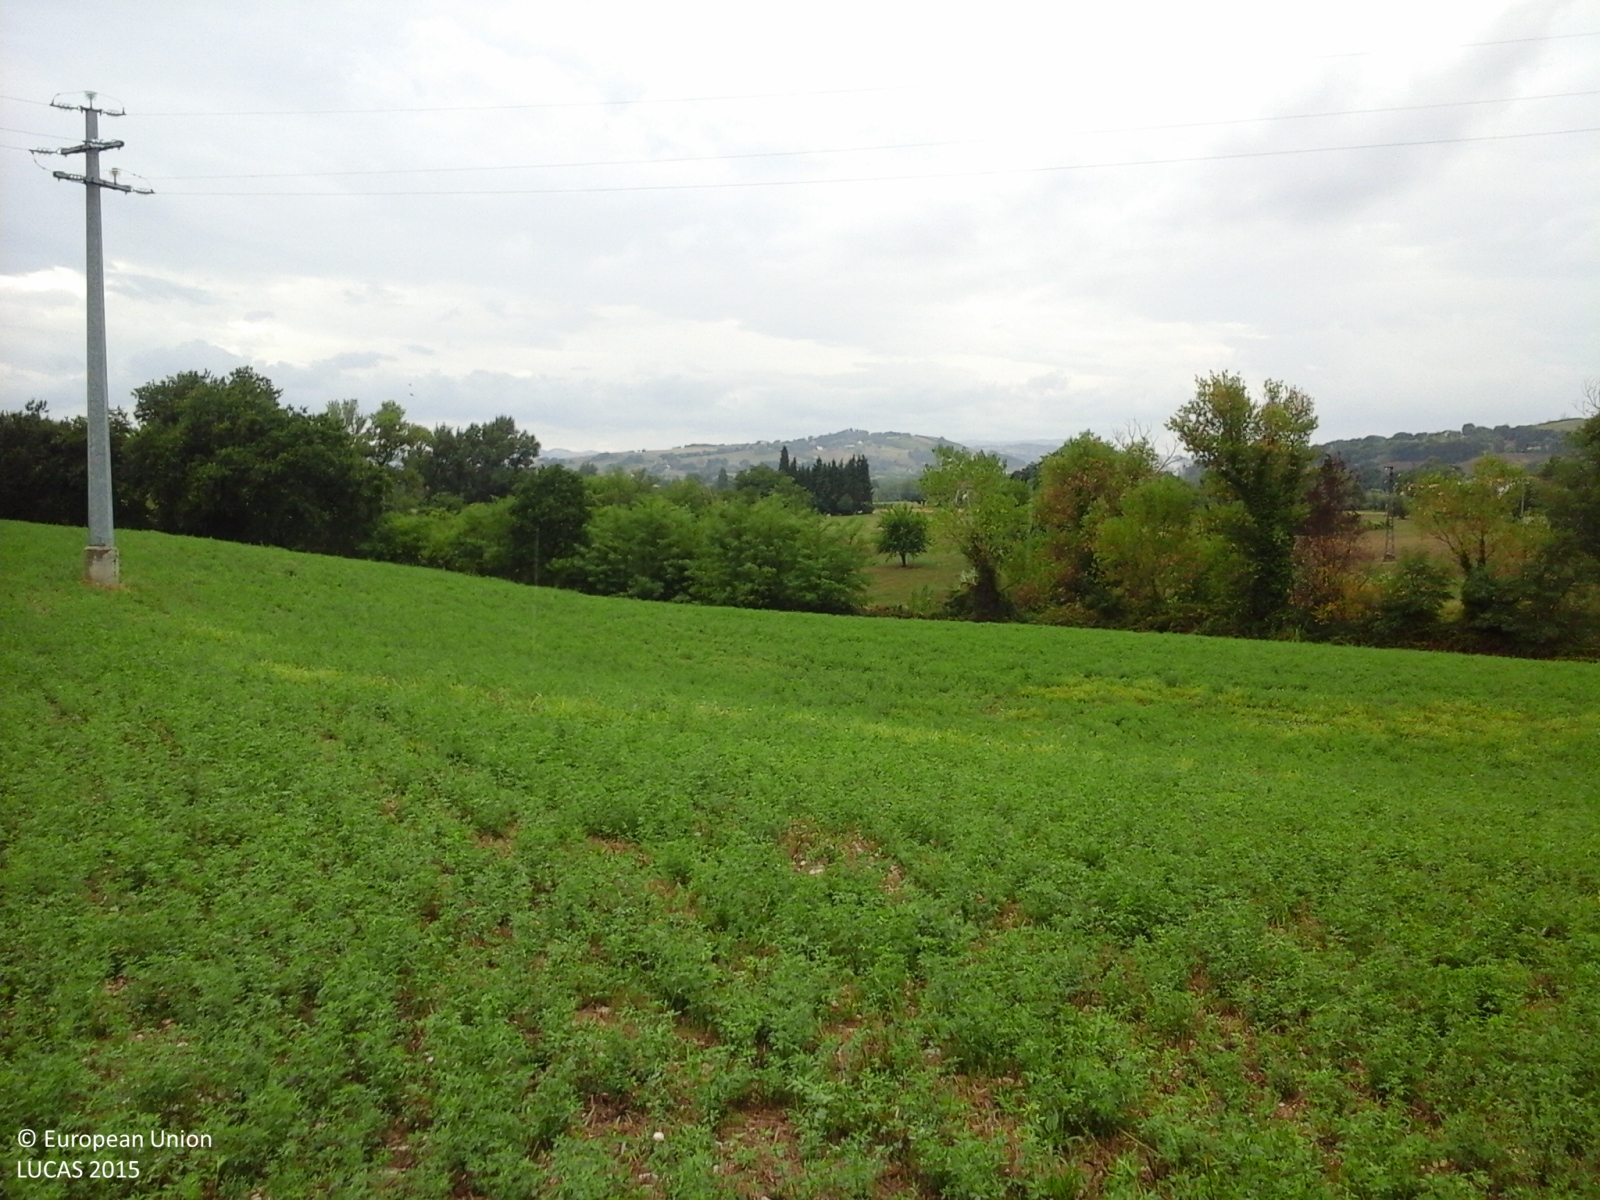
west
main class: Cropland
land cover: Lucerne
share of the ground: > 75 %
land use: Agriculture (excluding fallow land and kitchen gardens)
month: August
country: IT
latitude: 43.6572
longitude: 13.0058
